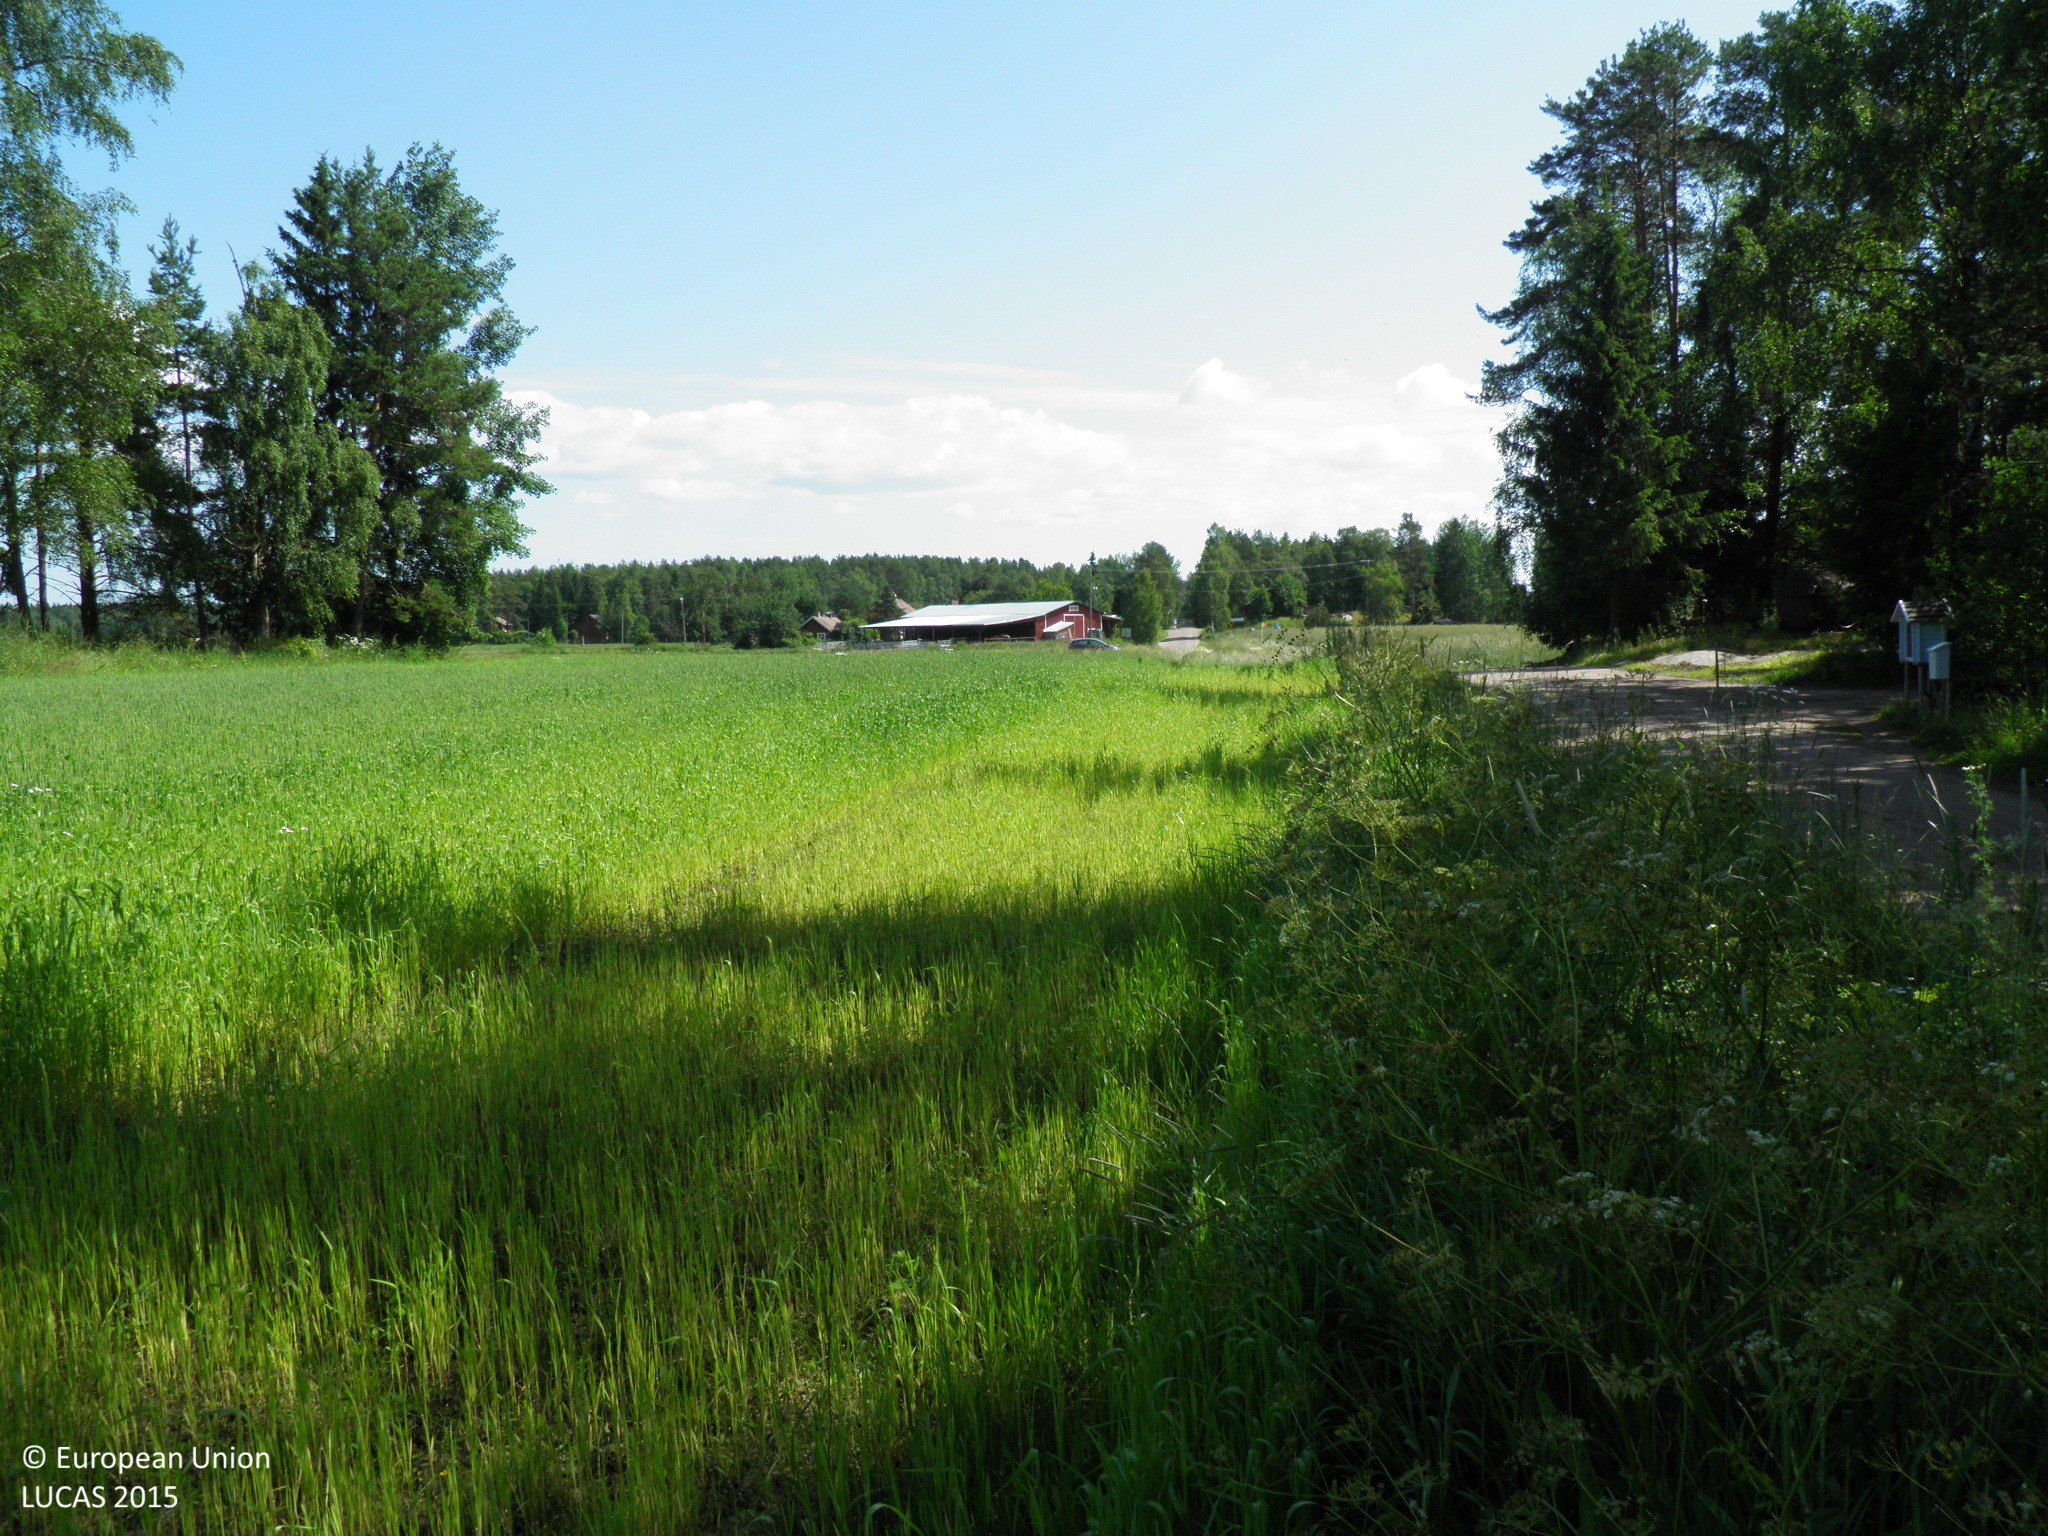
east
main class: Cropland
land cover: Common wheat
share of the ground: > 75 %
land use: Agriculture (excluding fallow land and kitchen gardens)
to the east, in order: Common wheat; Grass margins; Ditches and canals; Grass margins; Tracks; Grass margins; Ditches and canals; Grass margins; Fences; Grass margins; Potatoes; Fences; Grassland without tree/shrub cover; Inland fresh running water; Grassland without tree/shrub cover
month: July
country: FI
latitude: 60.9205
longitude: 22.4805
